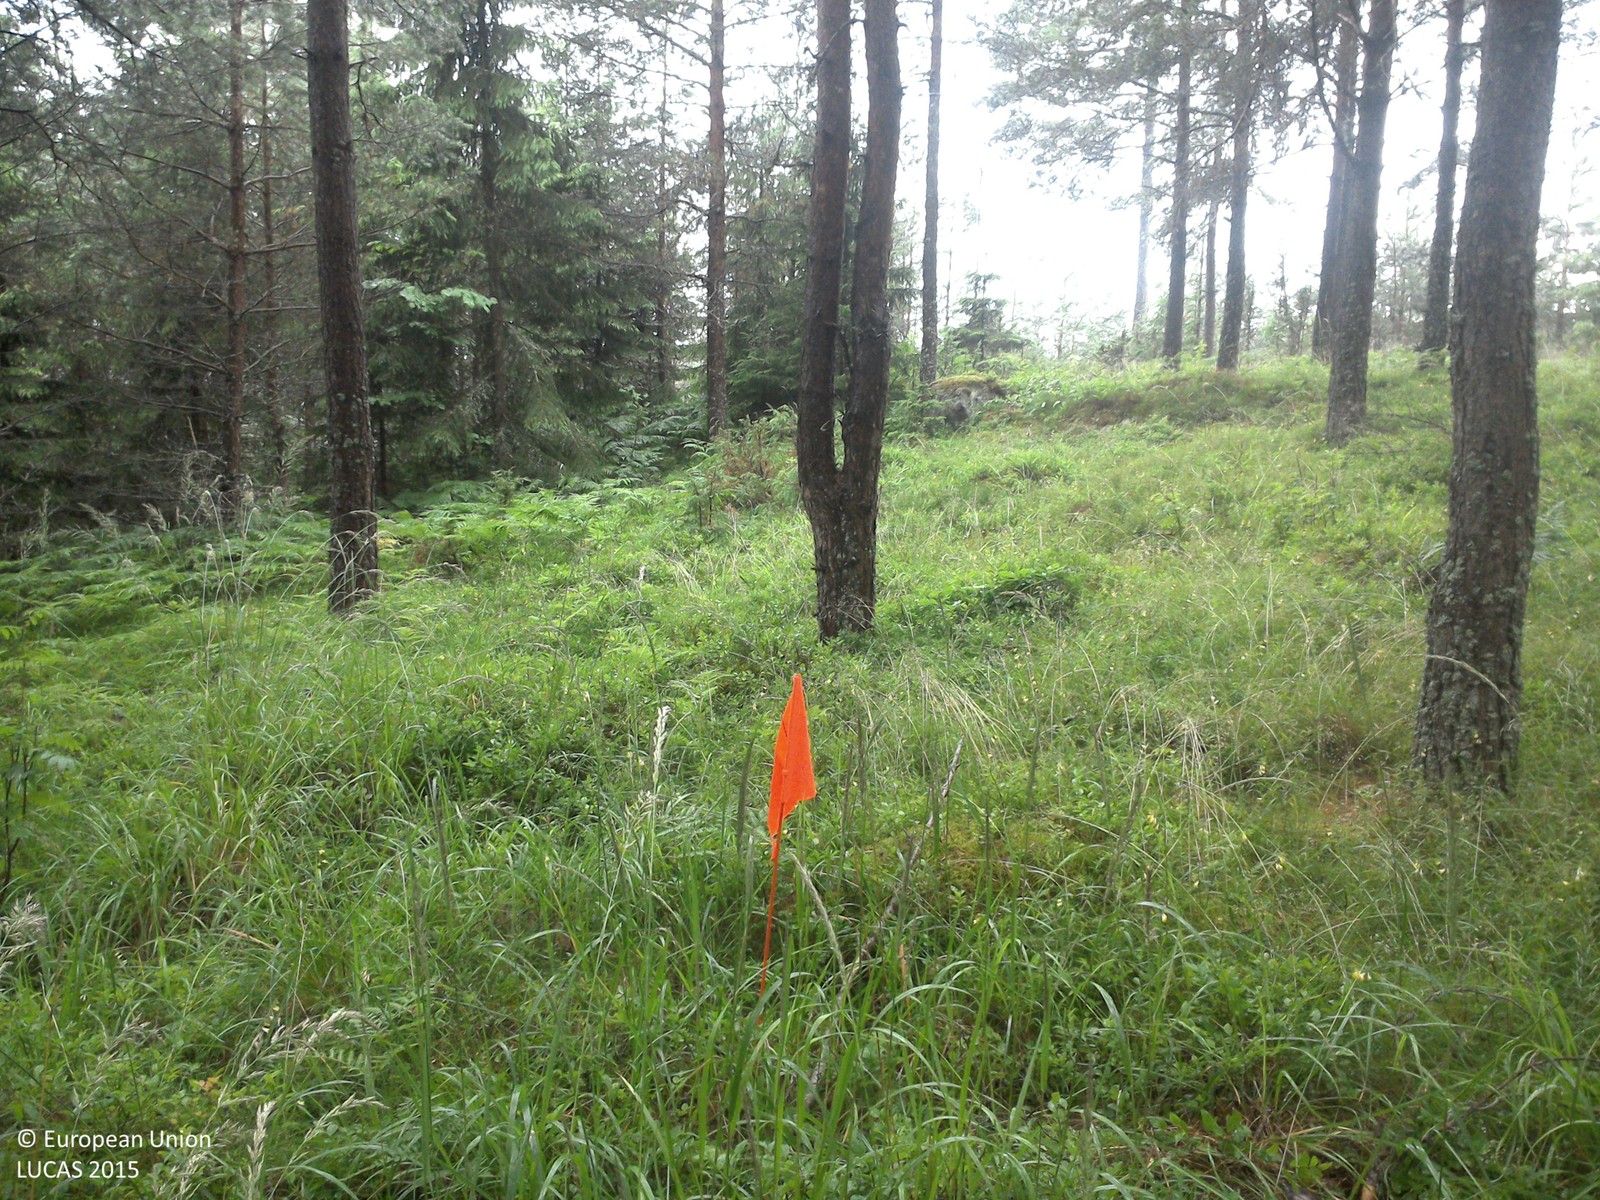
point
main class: Woodland
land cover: Pine dominated coniferous woodland
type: boreal forest
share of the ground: > 75 %
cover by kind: coniferous forest trees 75 %, herbaceous plants 25 %
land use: Forestry
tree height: > 5 m
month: July
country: SE
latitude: 58.6093
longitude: 15.1057
